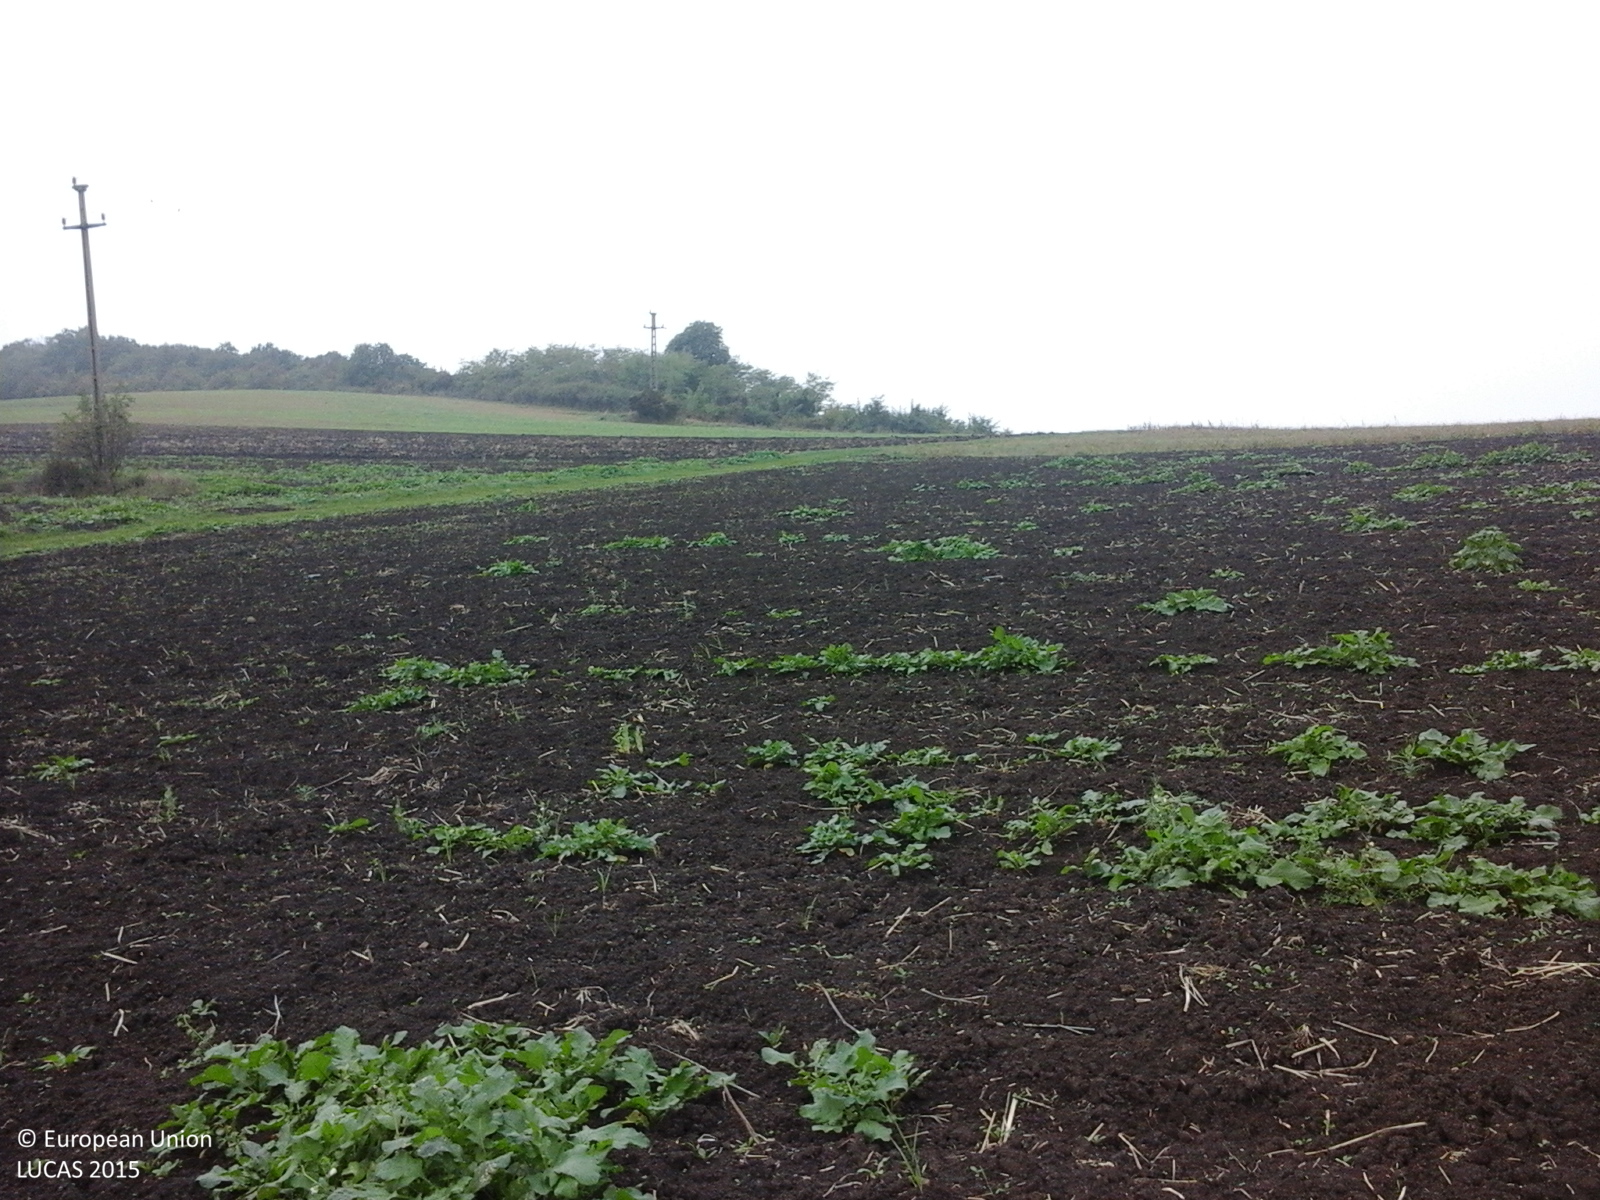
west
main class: Cropland
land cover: Rape and turnip rape
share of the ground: 50 - 75 %
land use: Agriculture (excluding fallow land and kitchen gardens)
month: October
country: RO
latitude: 46.4006
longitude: 24.2186
